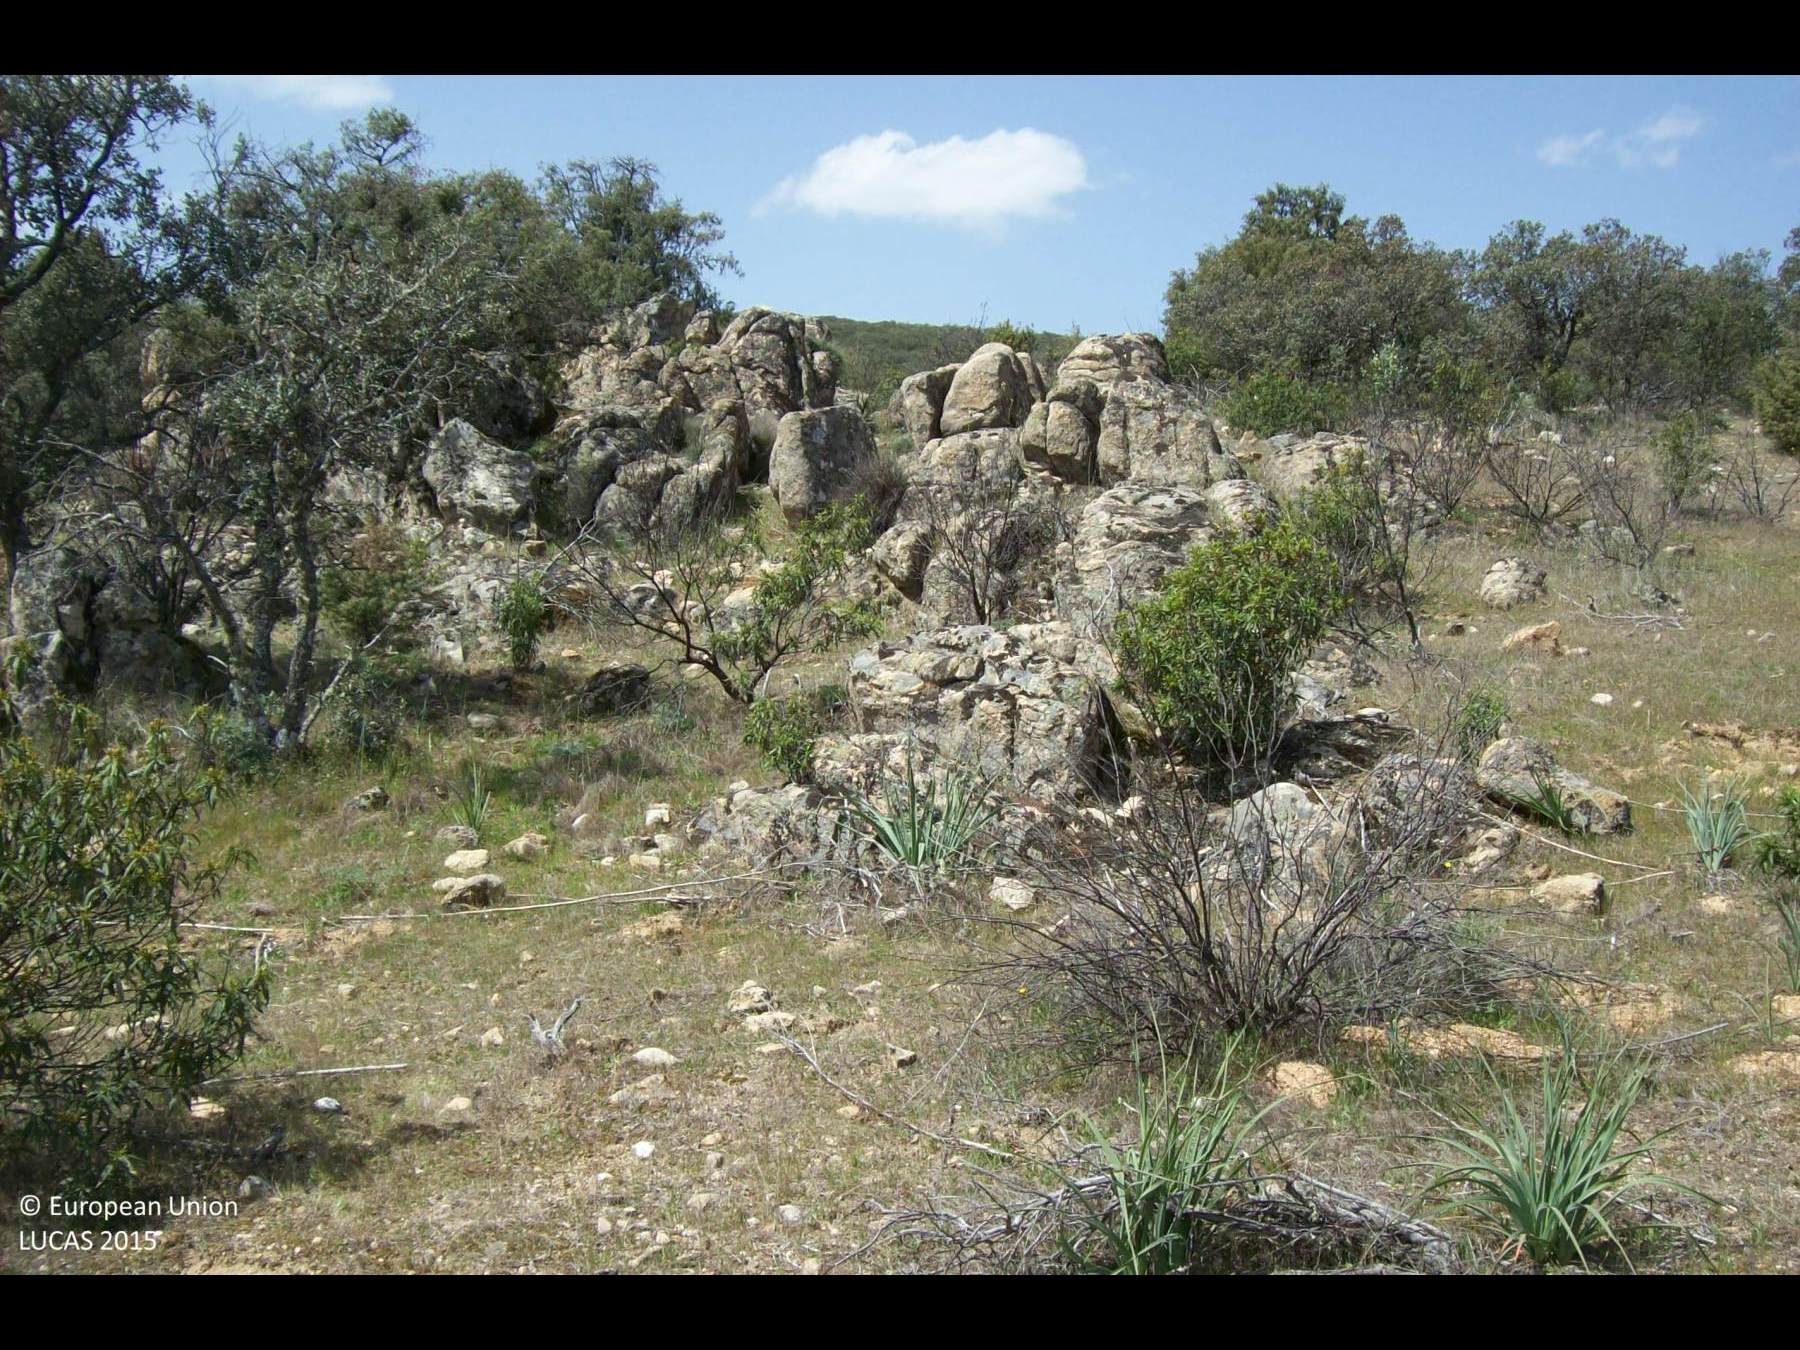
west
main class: Woodland
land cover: Broadleaved woodland
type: broadleaved evergreen forest
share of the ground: 25 - 50 %
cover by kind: herbaceous plants 50 %, broadleaved forest trees 25 %, shrubs 25 %
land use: Semi-natural and natural areas not in use
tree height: < 5 m
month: April
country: ES
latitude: 40.6026
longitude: -3.9529
